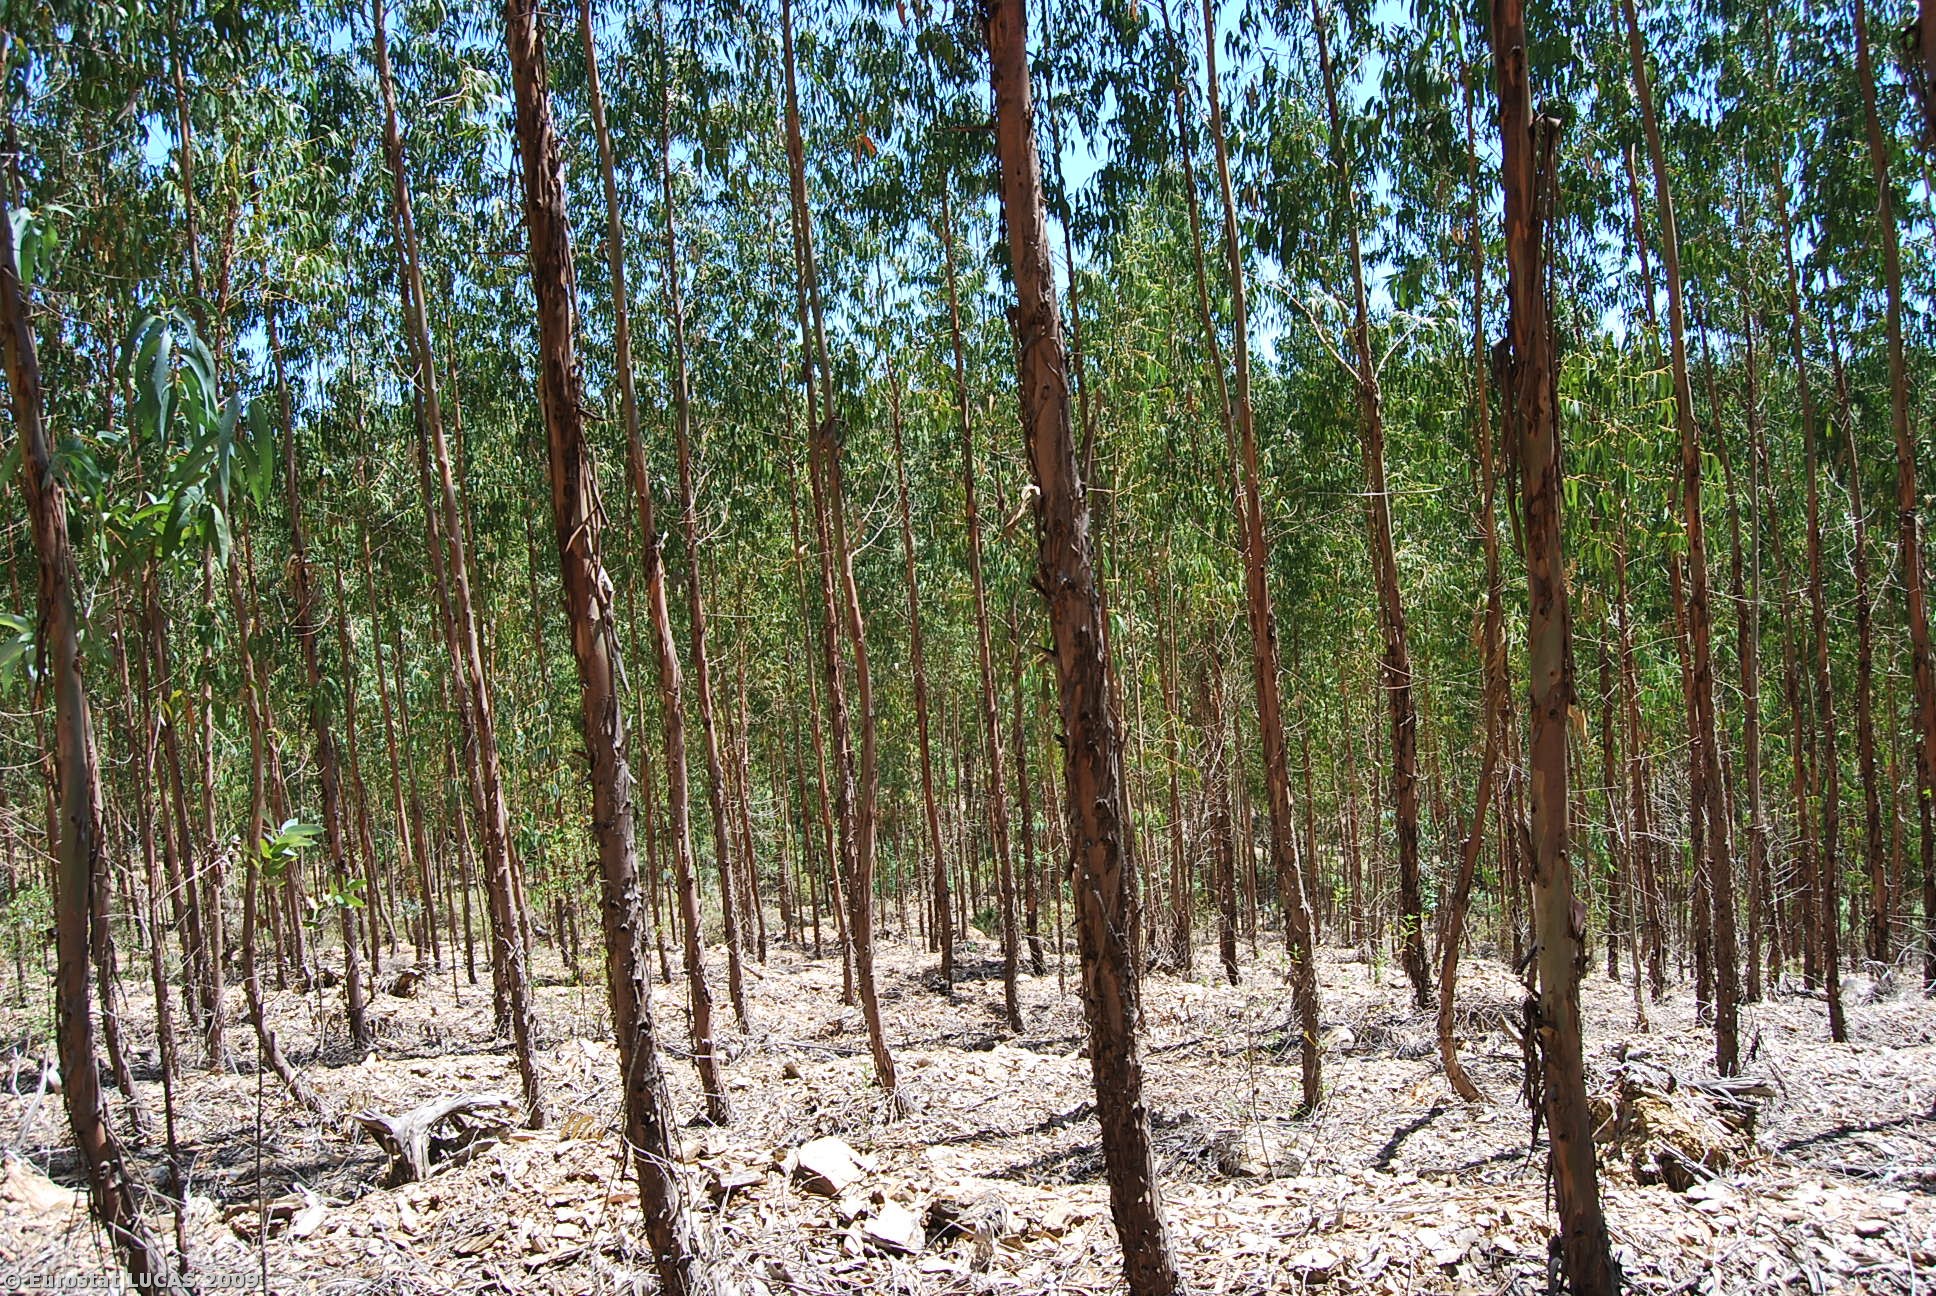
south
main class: Woodland
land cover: Broadleaved woodland
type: plantations and self-sown exotic forest
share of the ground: 50 - 75 %
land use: Forestry
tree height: > 5 m
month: July
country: PT
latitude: 37.6790
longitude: -8.4839
